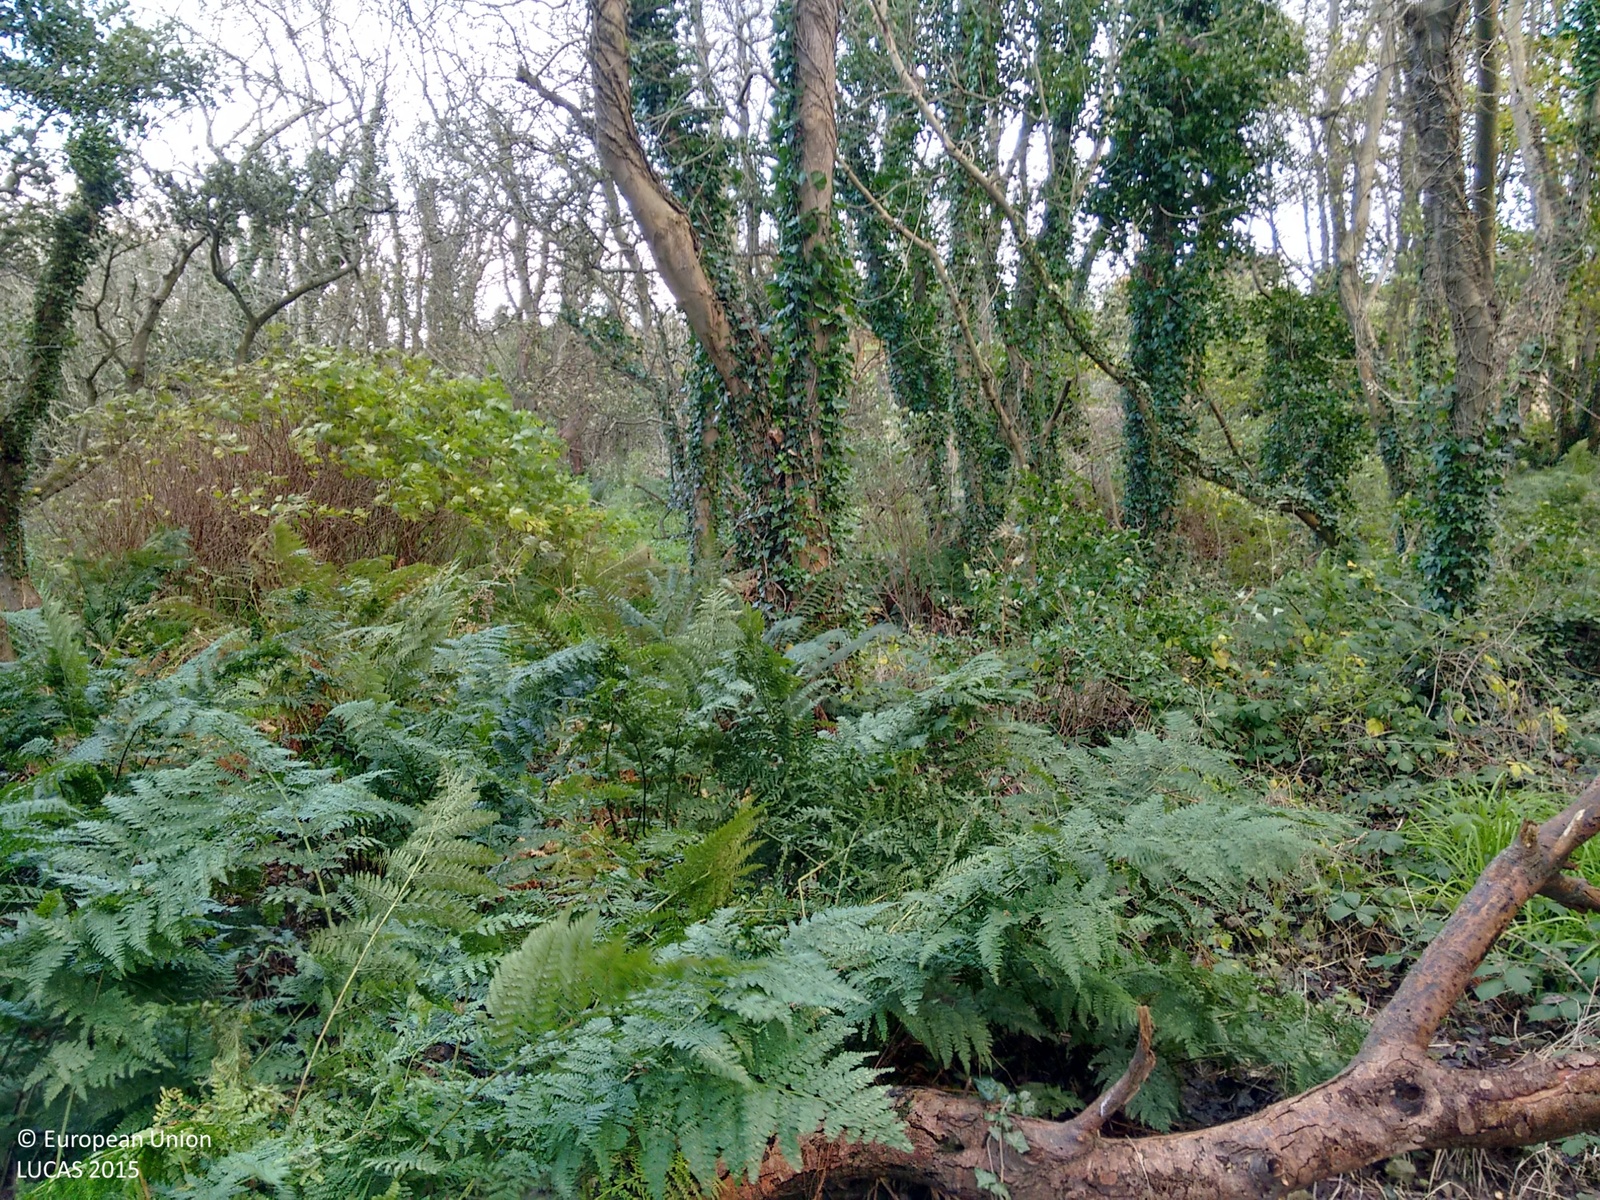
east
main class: Woodland
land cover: Broadleaved woodland
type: exotic forest
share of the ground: > 75 %
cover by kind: broadleaved forest trees 80 %, shrubs 10 %, herbaceous plants 10 %
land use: Semi-natural and natural areas not in use
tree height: > 5 m
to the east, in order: Broadleaved woodland; Rivers and streams; Artificial constructions in urban areas
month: November
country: GB
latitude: 54.6736
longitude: -5.7494
